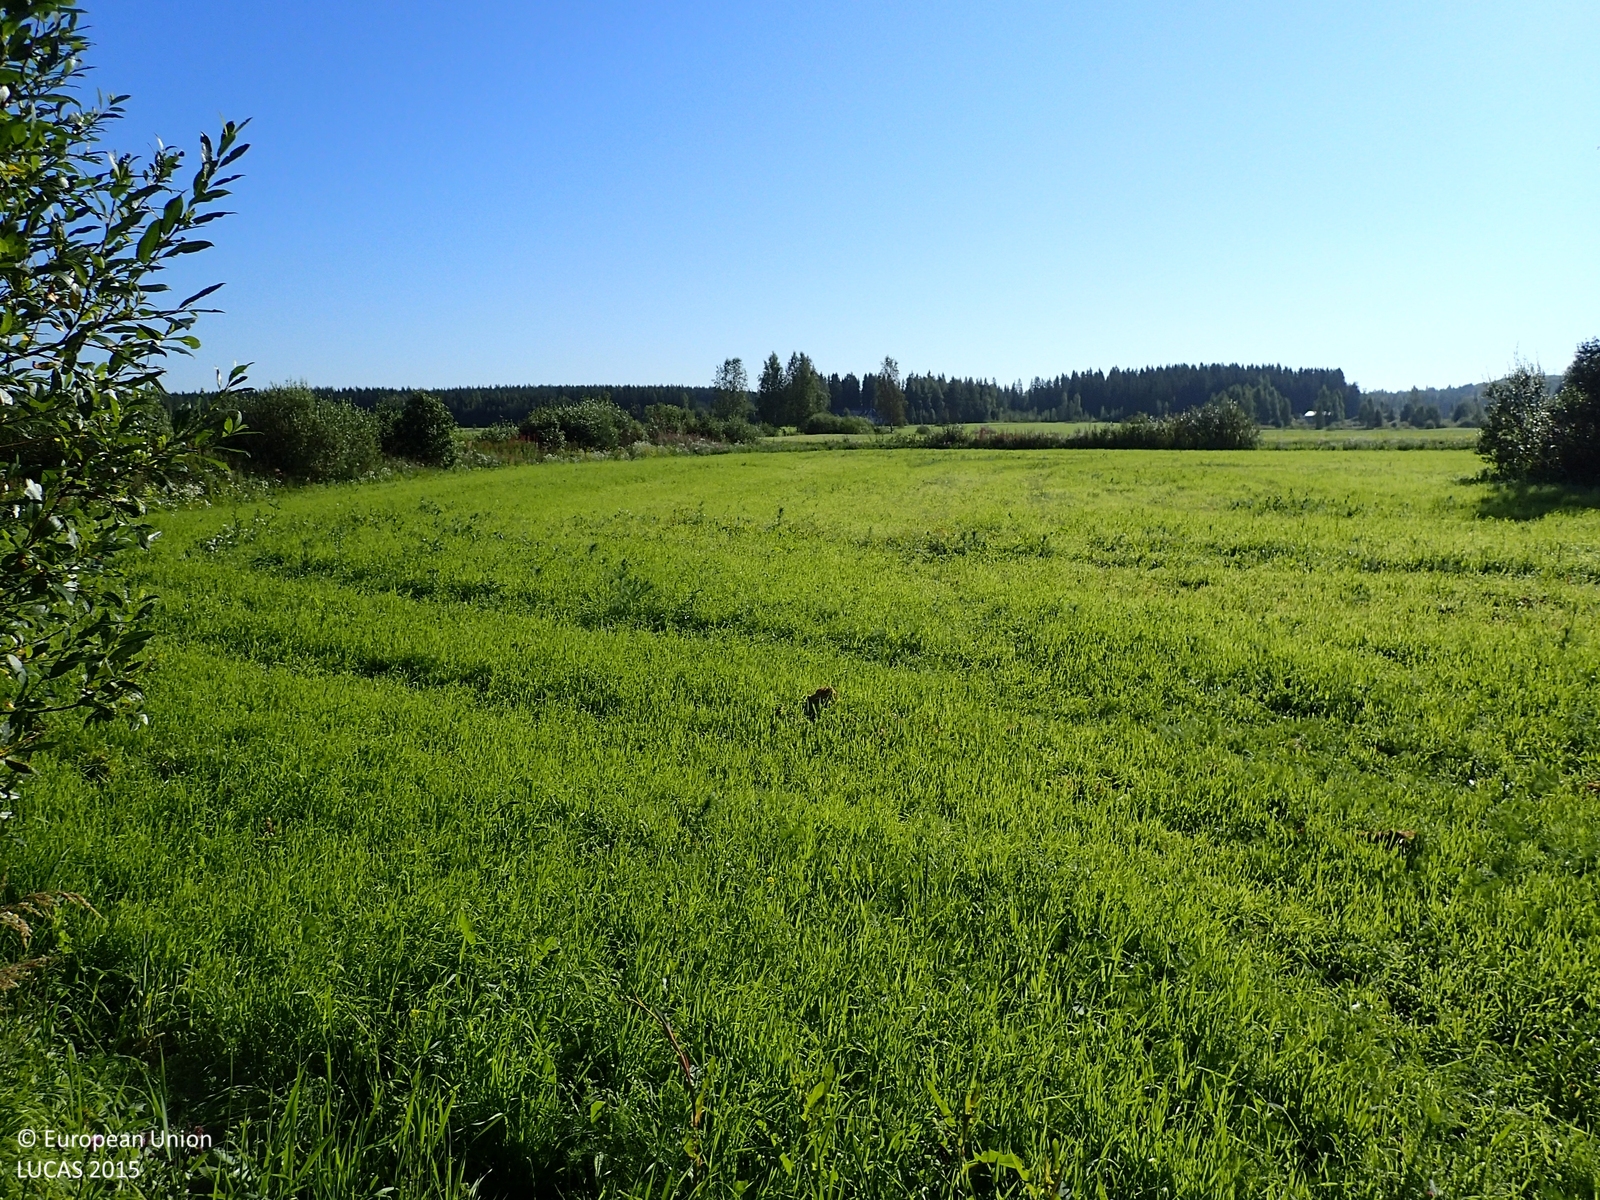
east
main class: Cropland
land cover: Temporary grasslands
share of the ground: > 75 %
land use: Agriculture (excluding fallow land and kitchen gardens)
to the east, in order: Temporary grasslands; Abandoned hedges; Ditches and canals; Barley; Shruby margins; Ditches and canals; Shruby margins; Barley
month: August
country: FI
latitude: 62.5080
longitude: 22.7388
